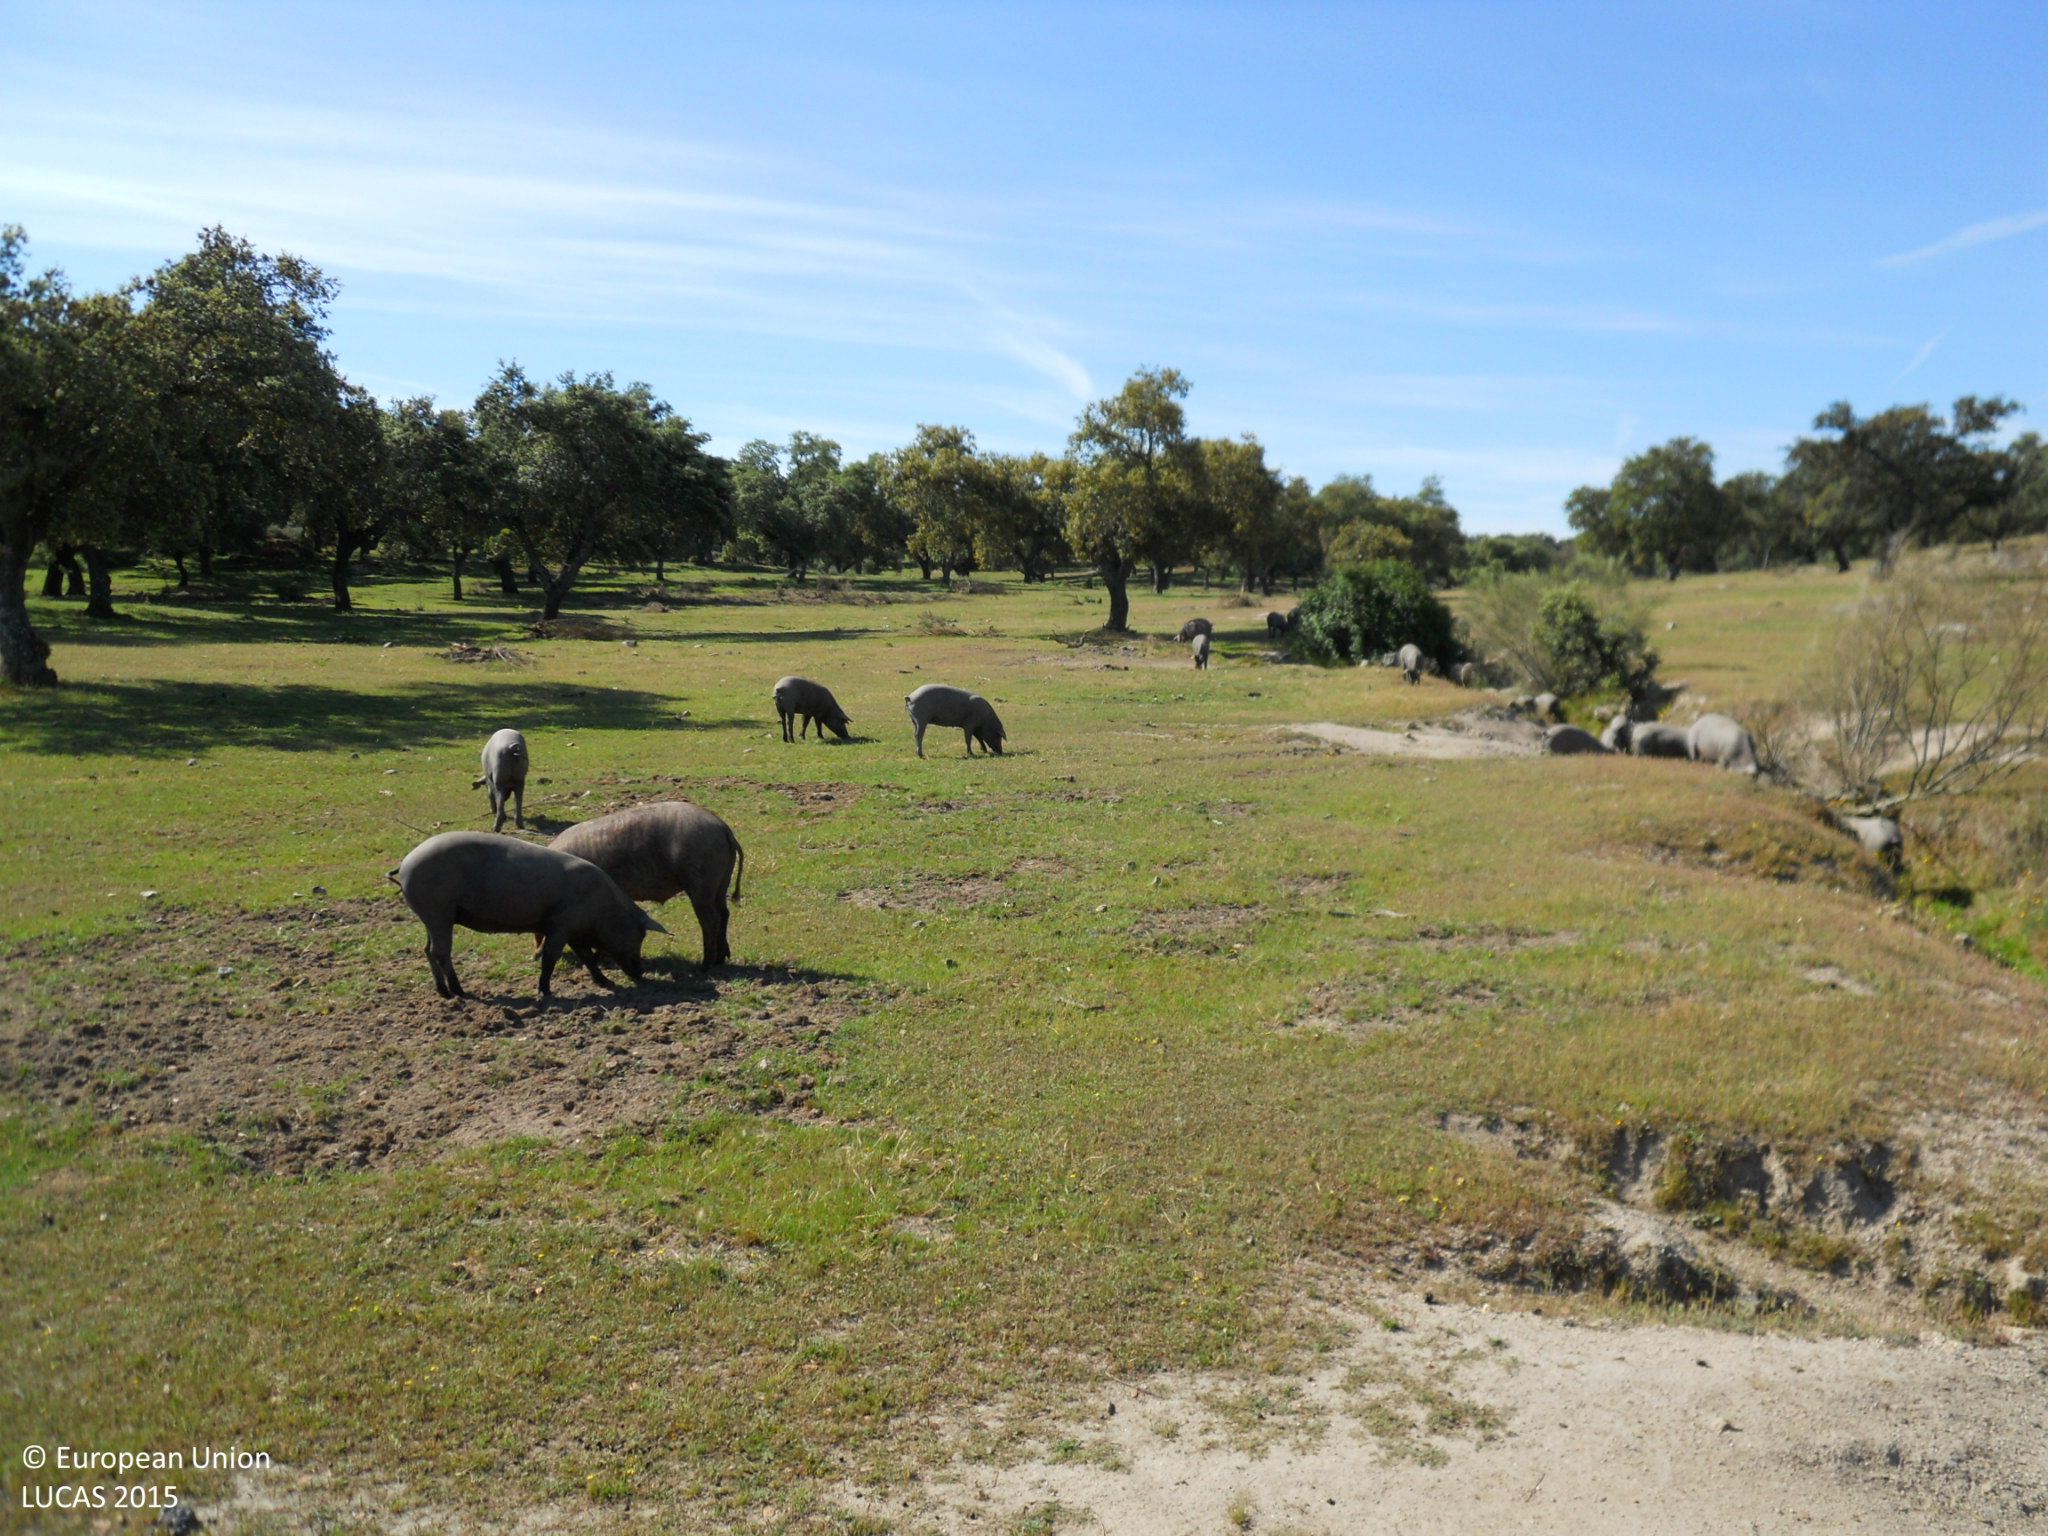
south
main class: Grassland
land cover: Grassland with sparse tree/shrub cover
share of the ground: > 75 %
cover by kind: herbaceous plants 70 %, unconsolidated bare surface 20 %, broadleaved forest trees 5 %, shrubs 5 %
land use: Agriculture (excluding fallow land and kitchen gardens)
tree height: > 5 m
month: April
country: ES
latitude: 39.3202
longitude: -7.0254
